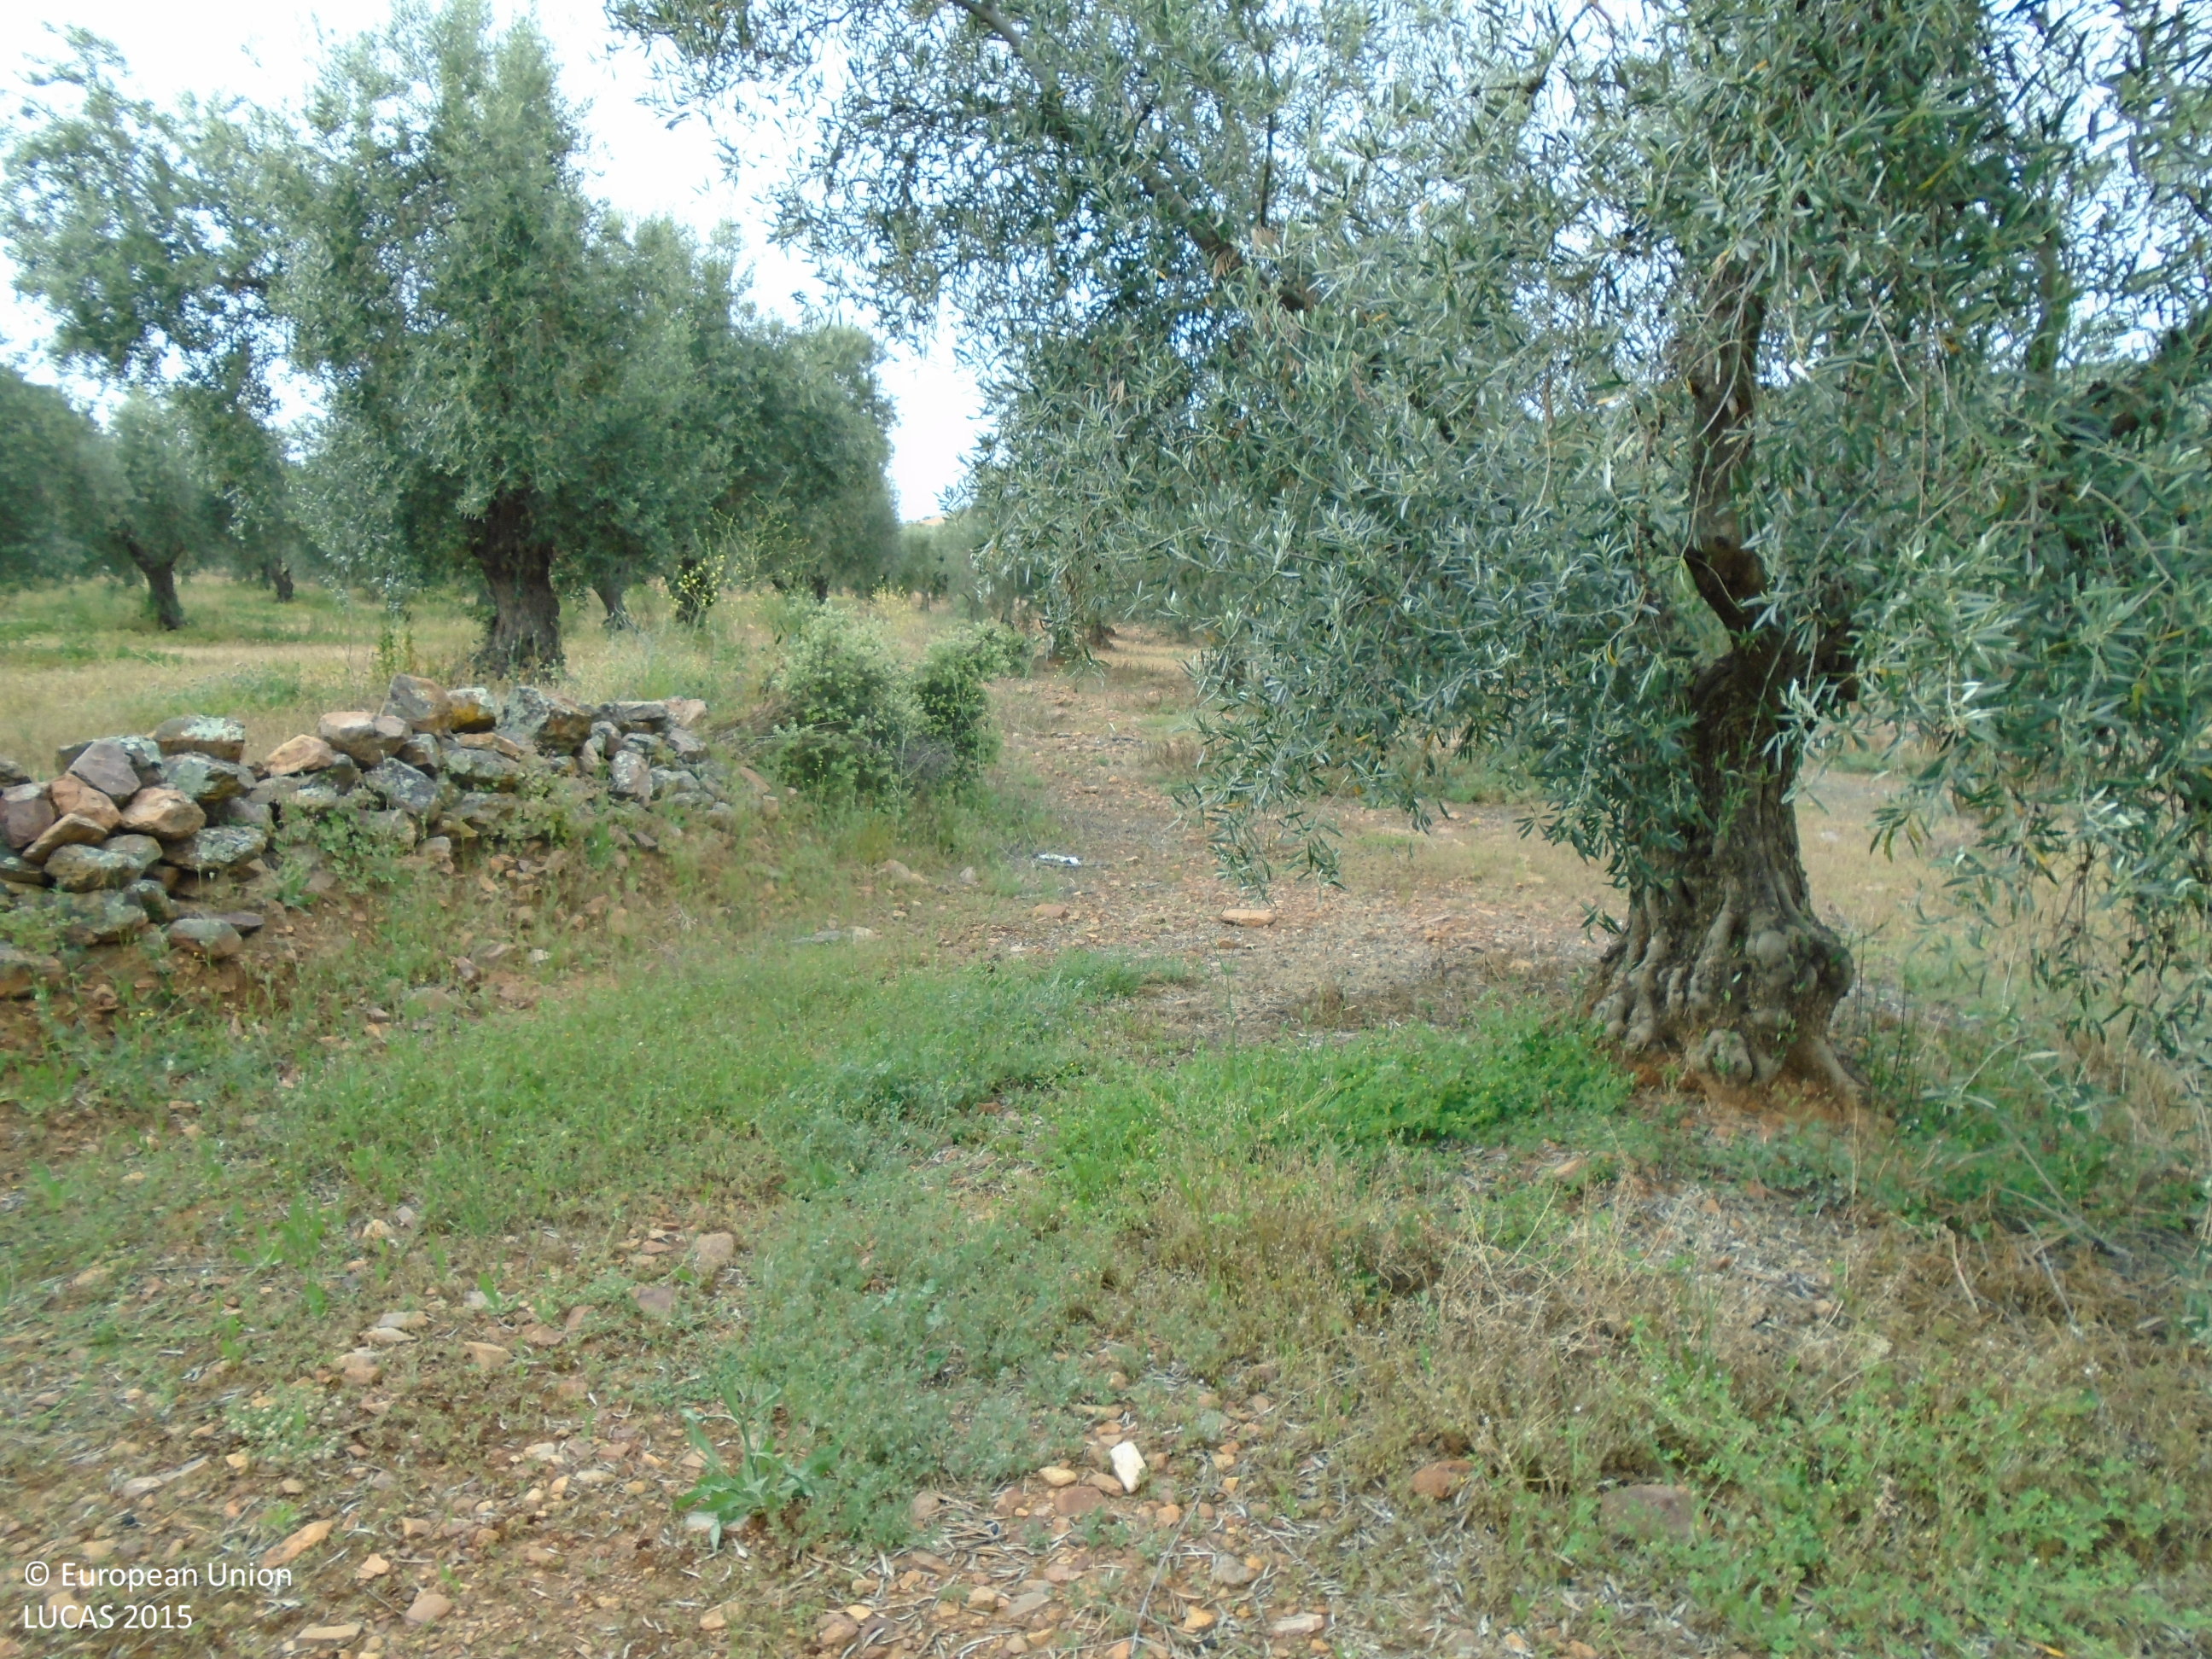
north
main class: Cropland
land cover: Olive groves
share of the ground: > 75 %
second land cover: Spontaneously vegetated surfaces
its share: > 75 %
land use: Agriculture (excluding fallow land and kitchen gardens)
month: May
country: ES
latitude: 39.6964
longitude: -4.6296
